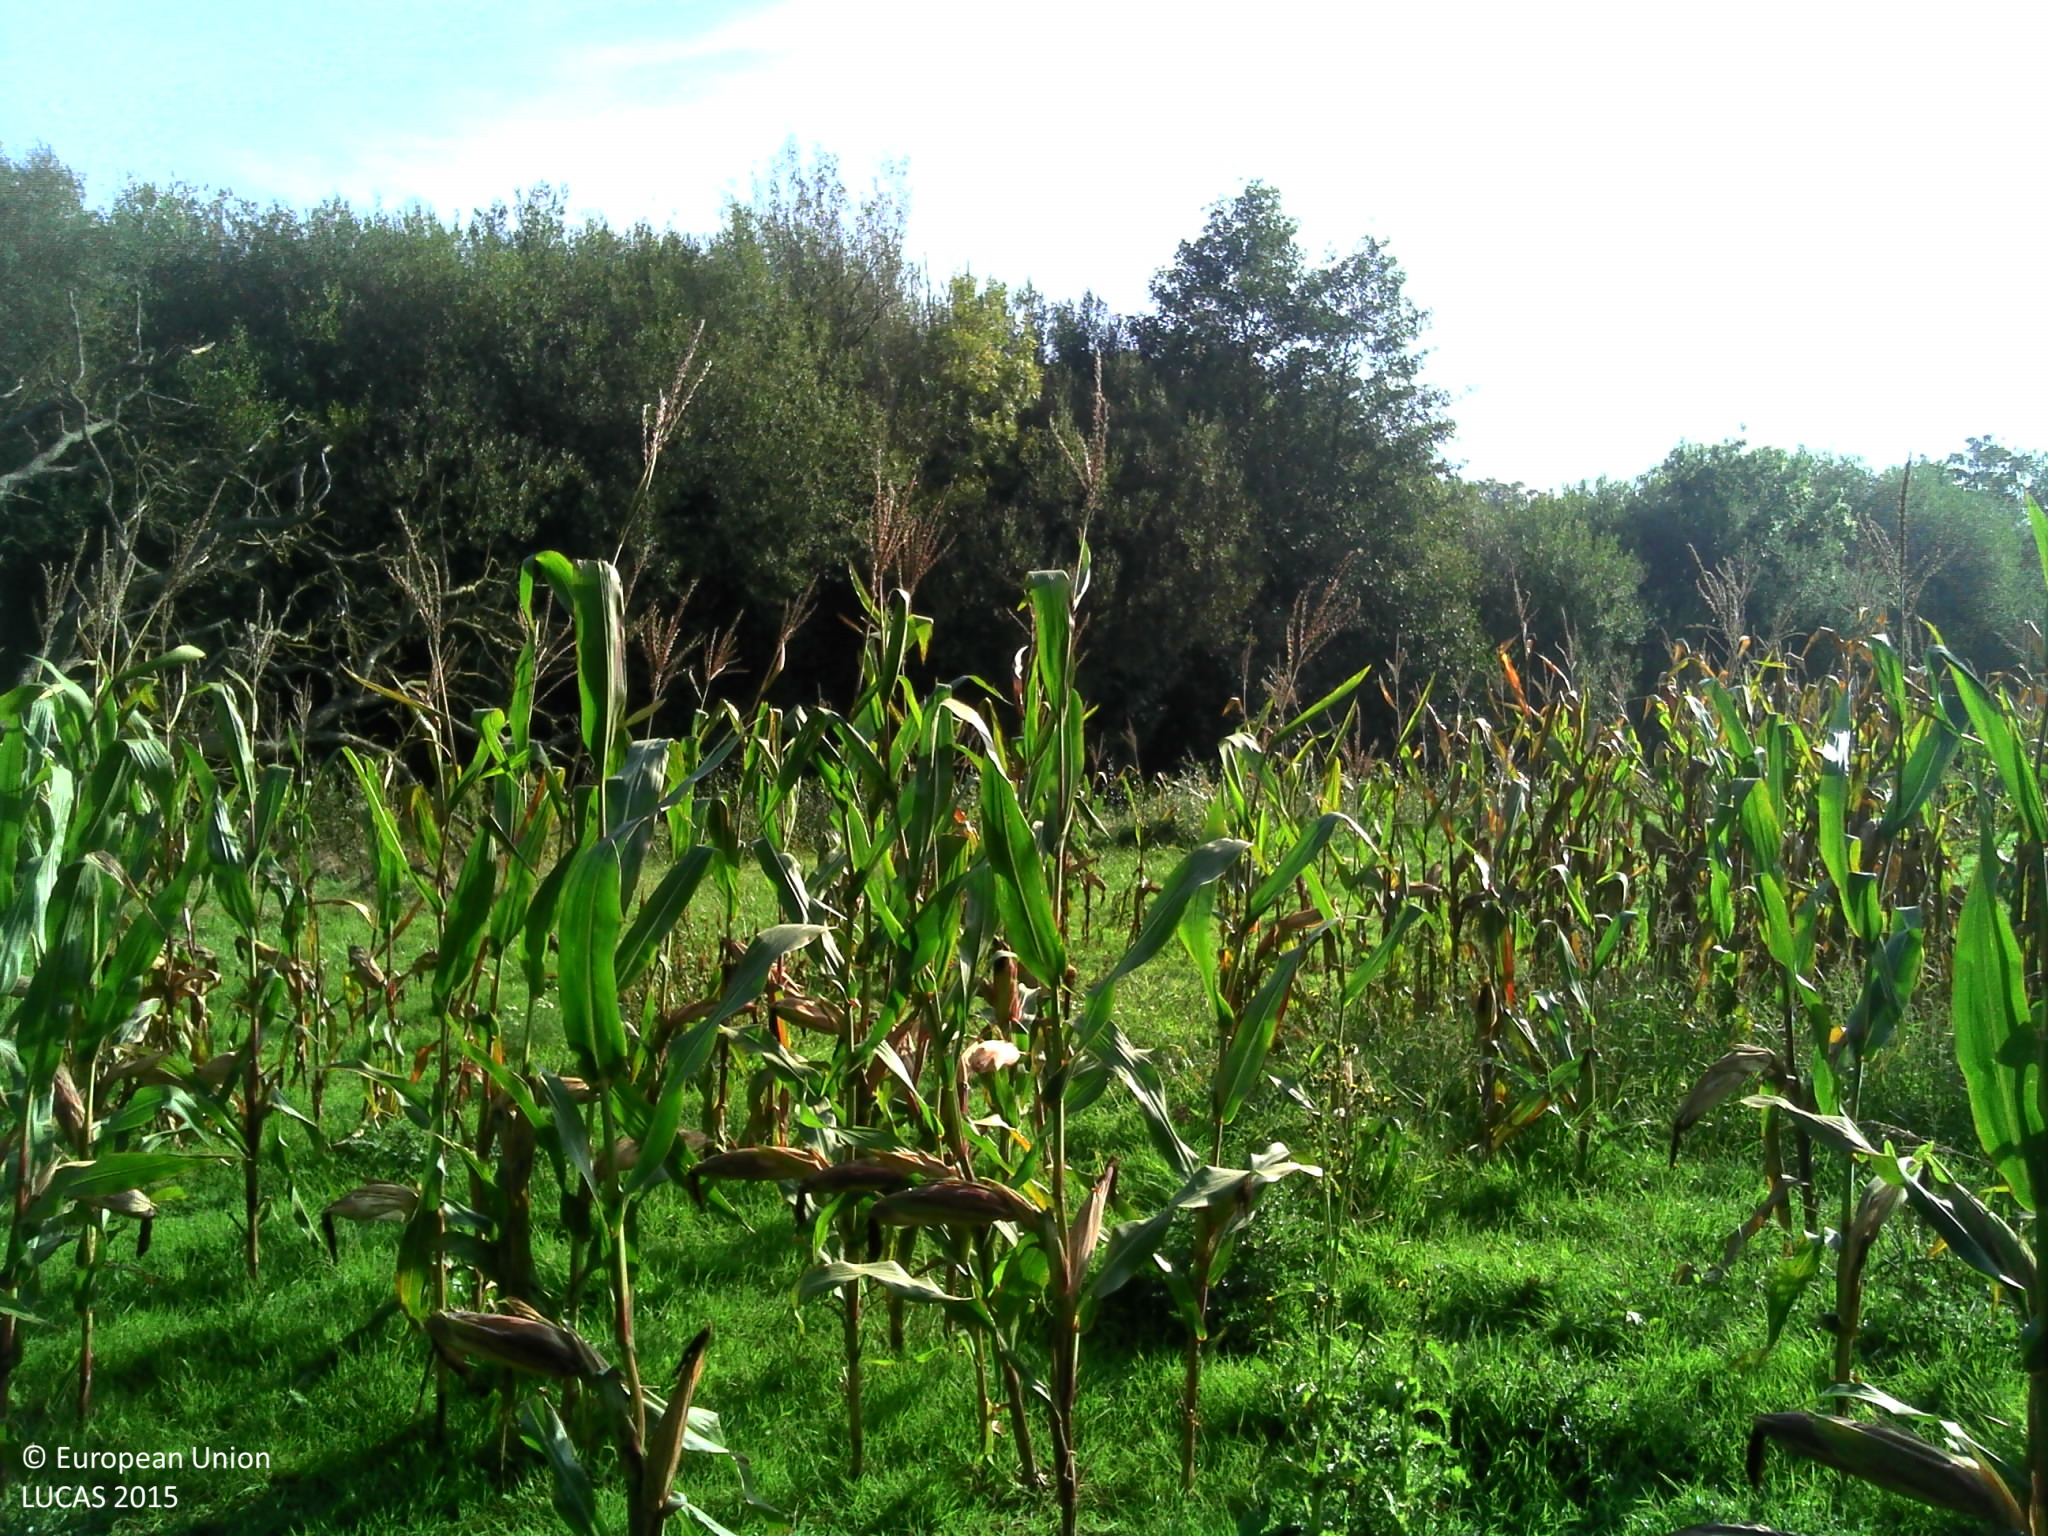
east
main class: Woodland
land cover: Broadleaved woodland
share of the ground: > 75 %
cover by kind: broadleaved forest trees 95 %, shrubs 5 %
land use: Semi-natural and natural areas not in use
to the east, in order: Broadleaved woodland; Grassland without tree/shrub cover; Maize; Grassland without tree/shrub cover; Rivers and streams; Broadleaved woodland; Fences; Tracks; Fences; Broadleaved woodland; Fences; Grassland without tree/shrub cover; Fences; Lines of trees; Grassland without tree/shrub cover; Artificial constructions in urban areas
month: October
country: FR
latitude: 47.2191
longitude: -0.9822
